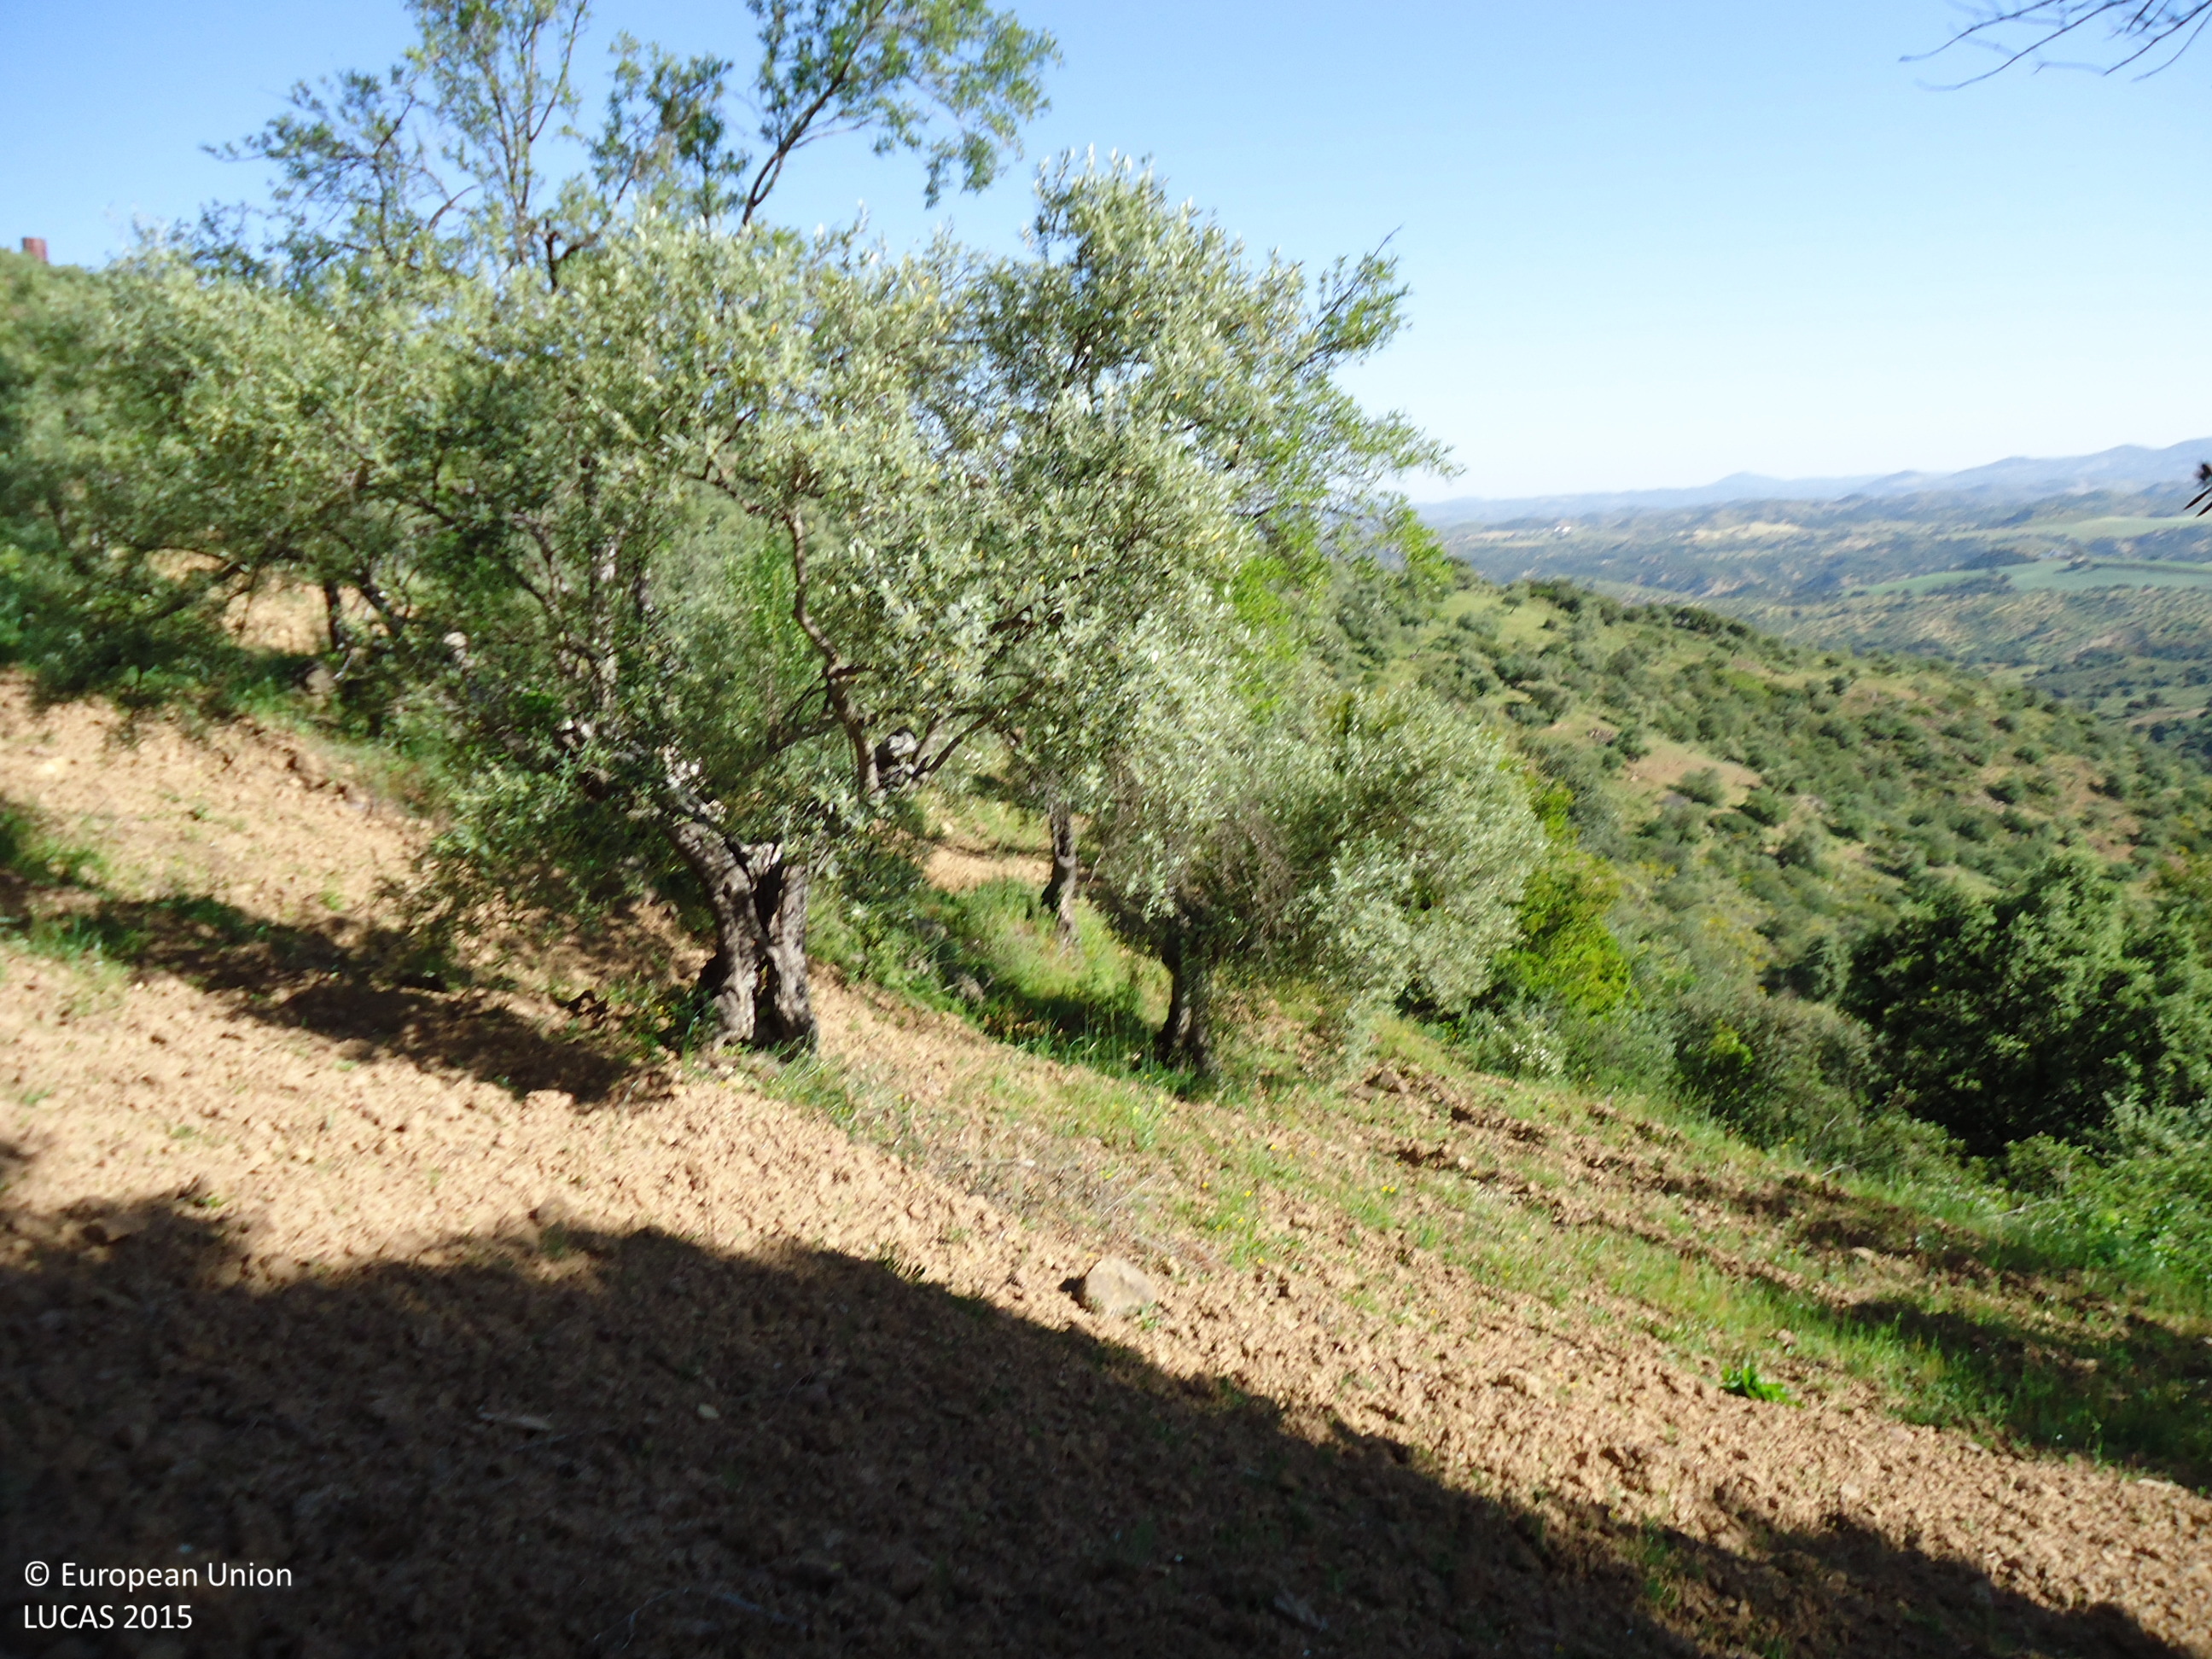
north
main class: Cropland
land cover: Olive groves
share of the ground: 50 - 75 %
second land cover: Other bare soil
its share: > 75 %
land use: Agriculture (excluding fallow land and kitchen gardens)
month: May
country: ES
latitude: 36.8637
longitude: -5.3375
